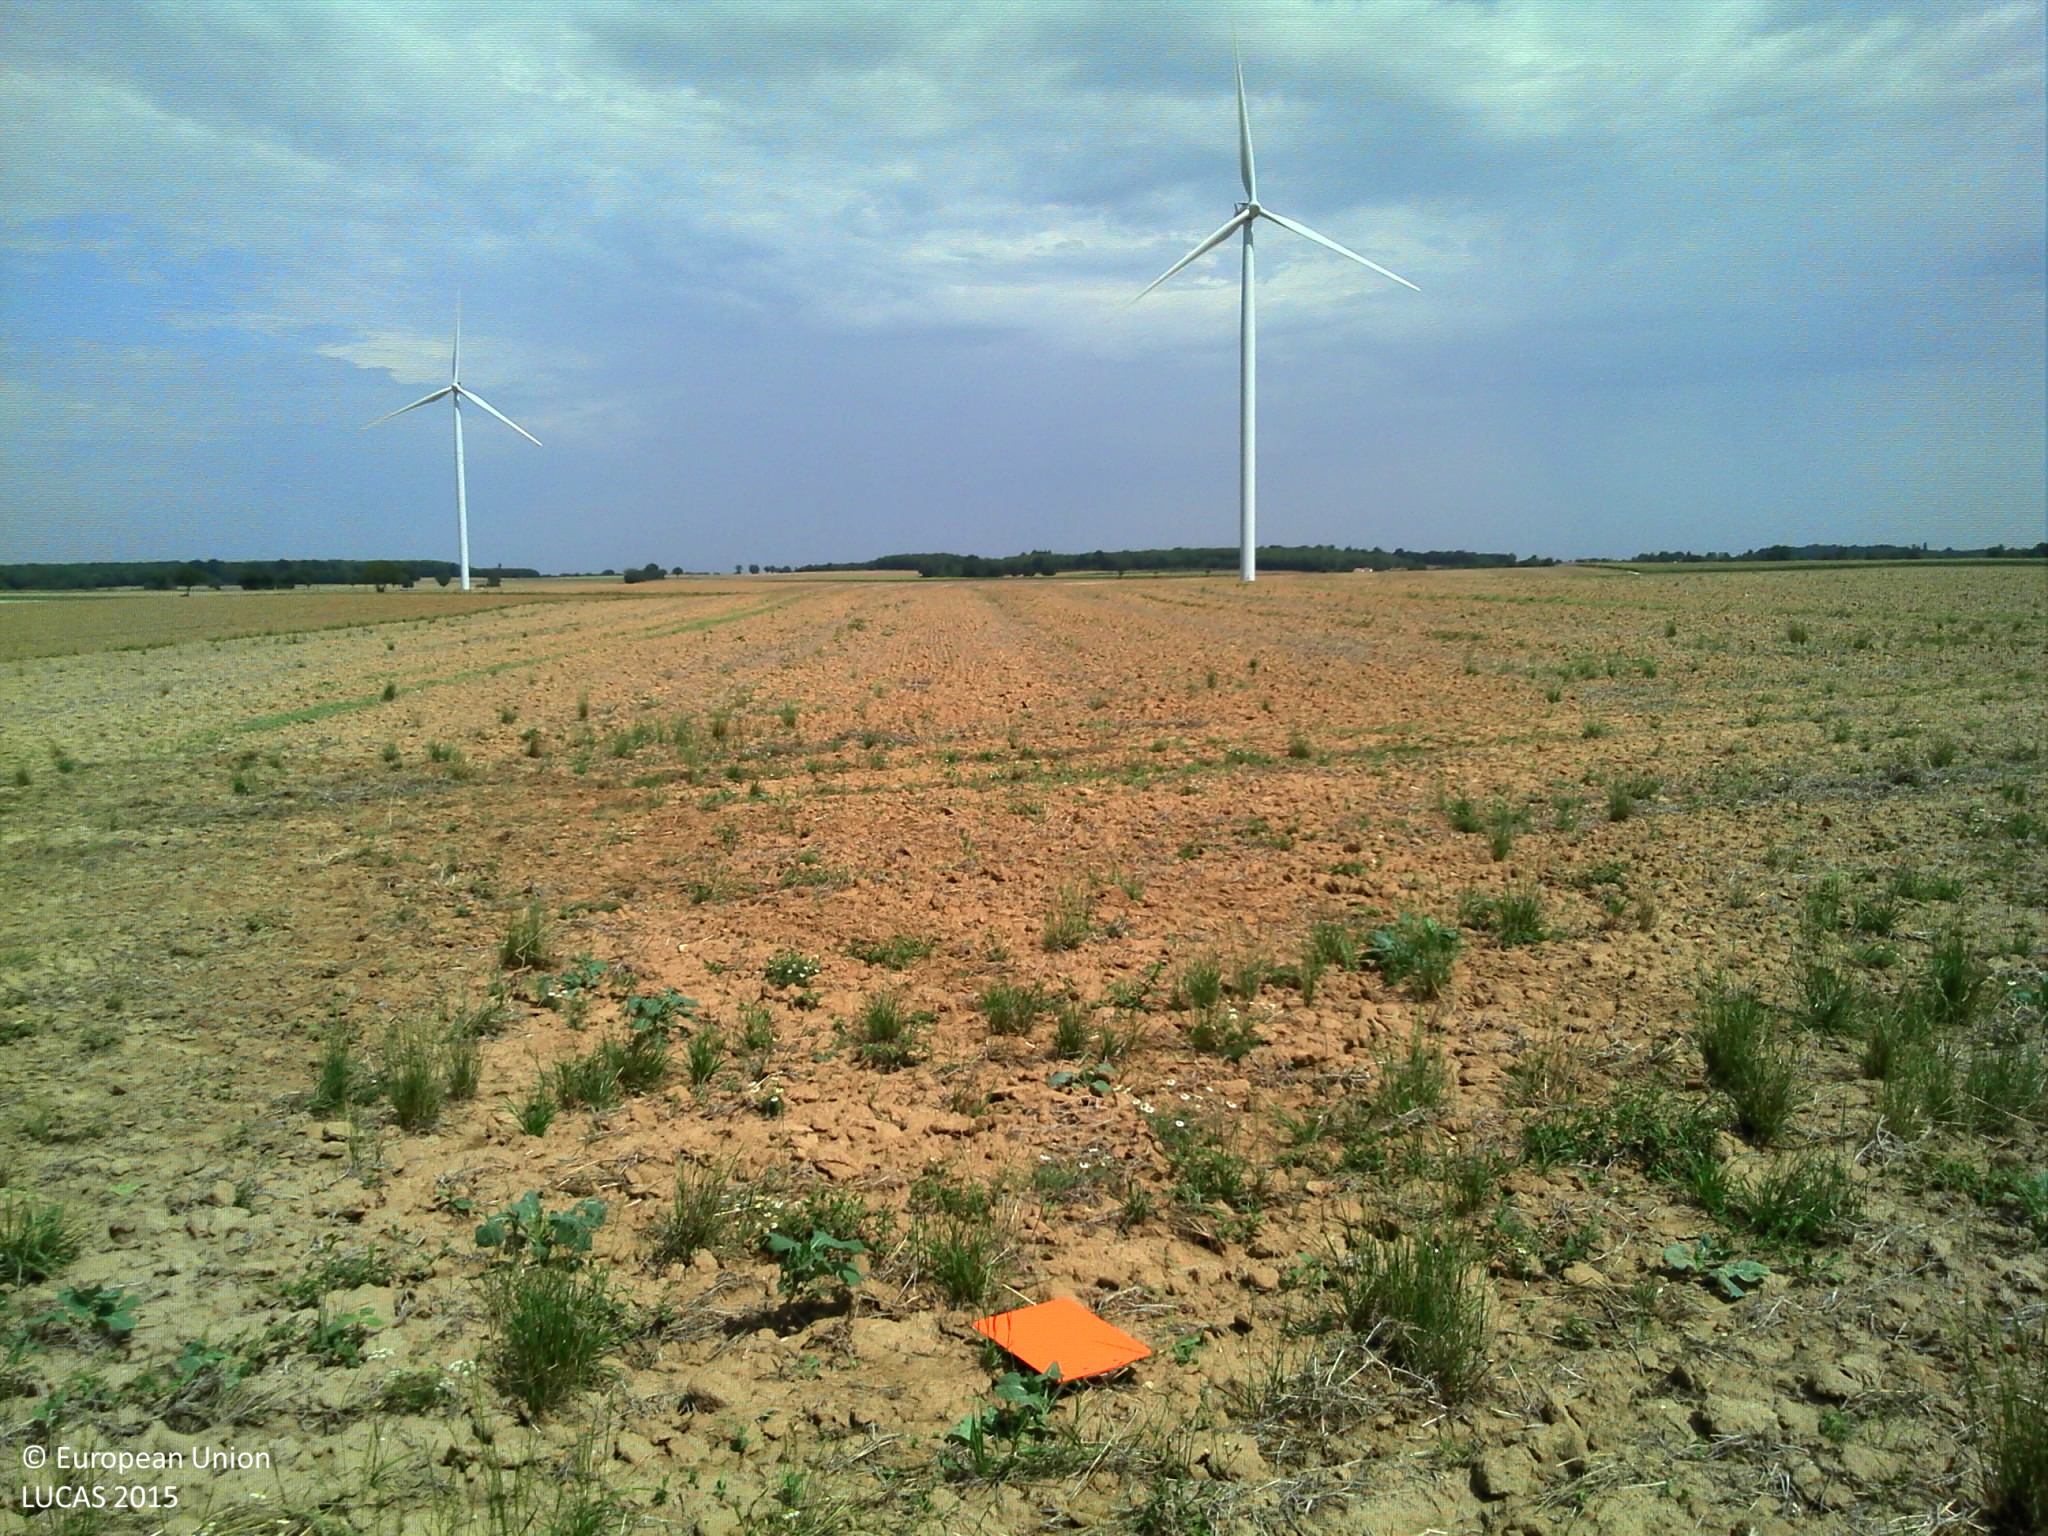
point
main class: Cropland
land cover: Dry pulses
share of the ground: < 10 %
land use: Agriculture (excluding fallow land and kitchen gardens)
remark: Tilled/Sowed
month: August
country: FR
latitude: 46.1058
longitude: 0.2666
